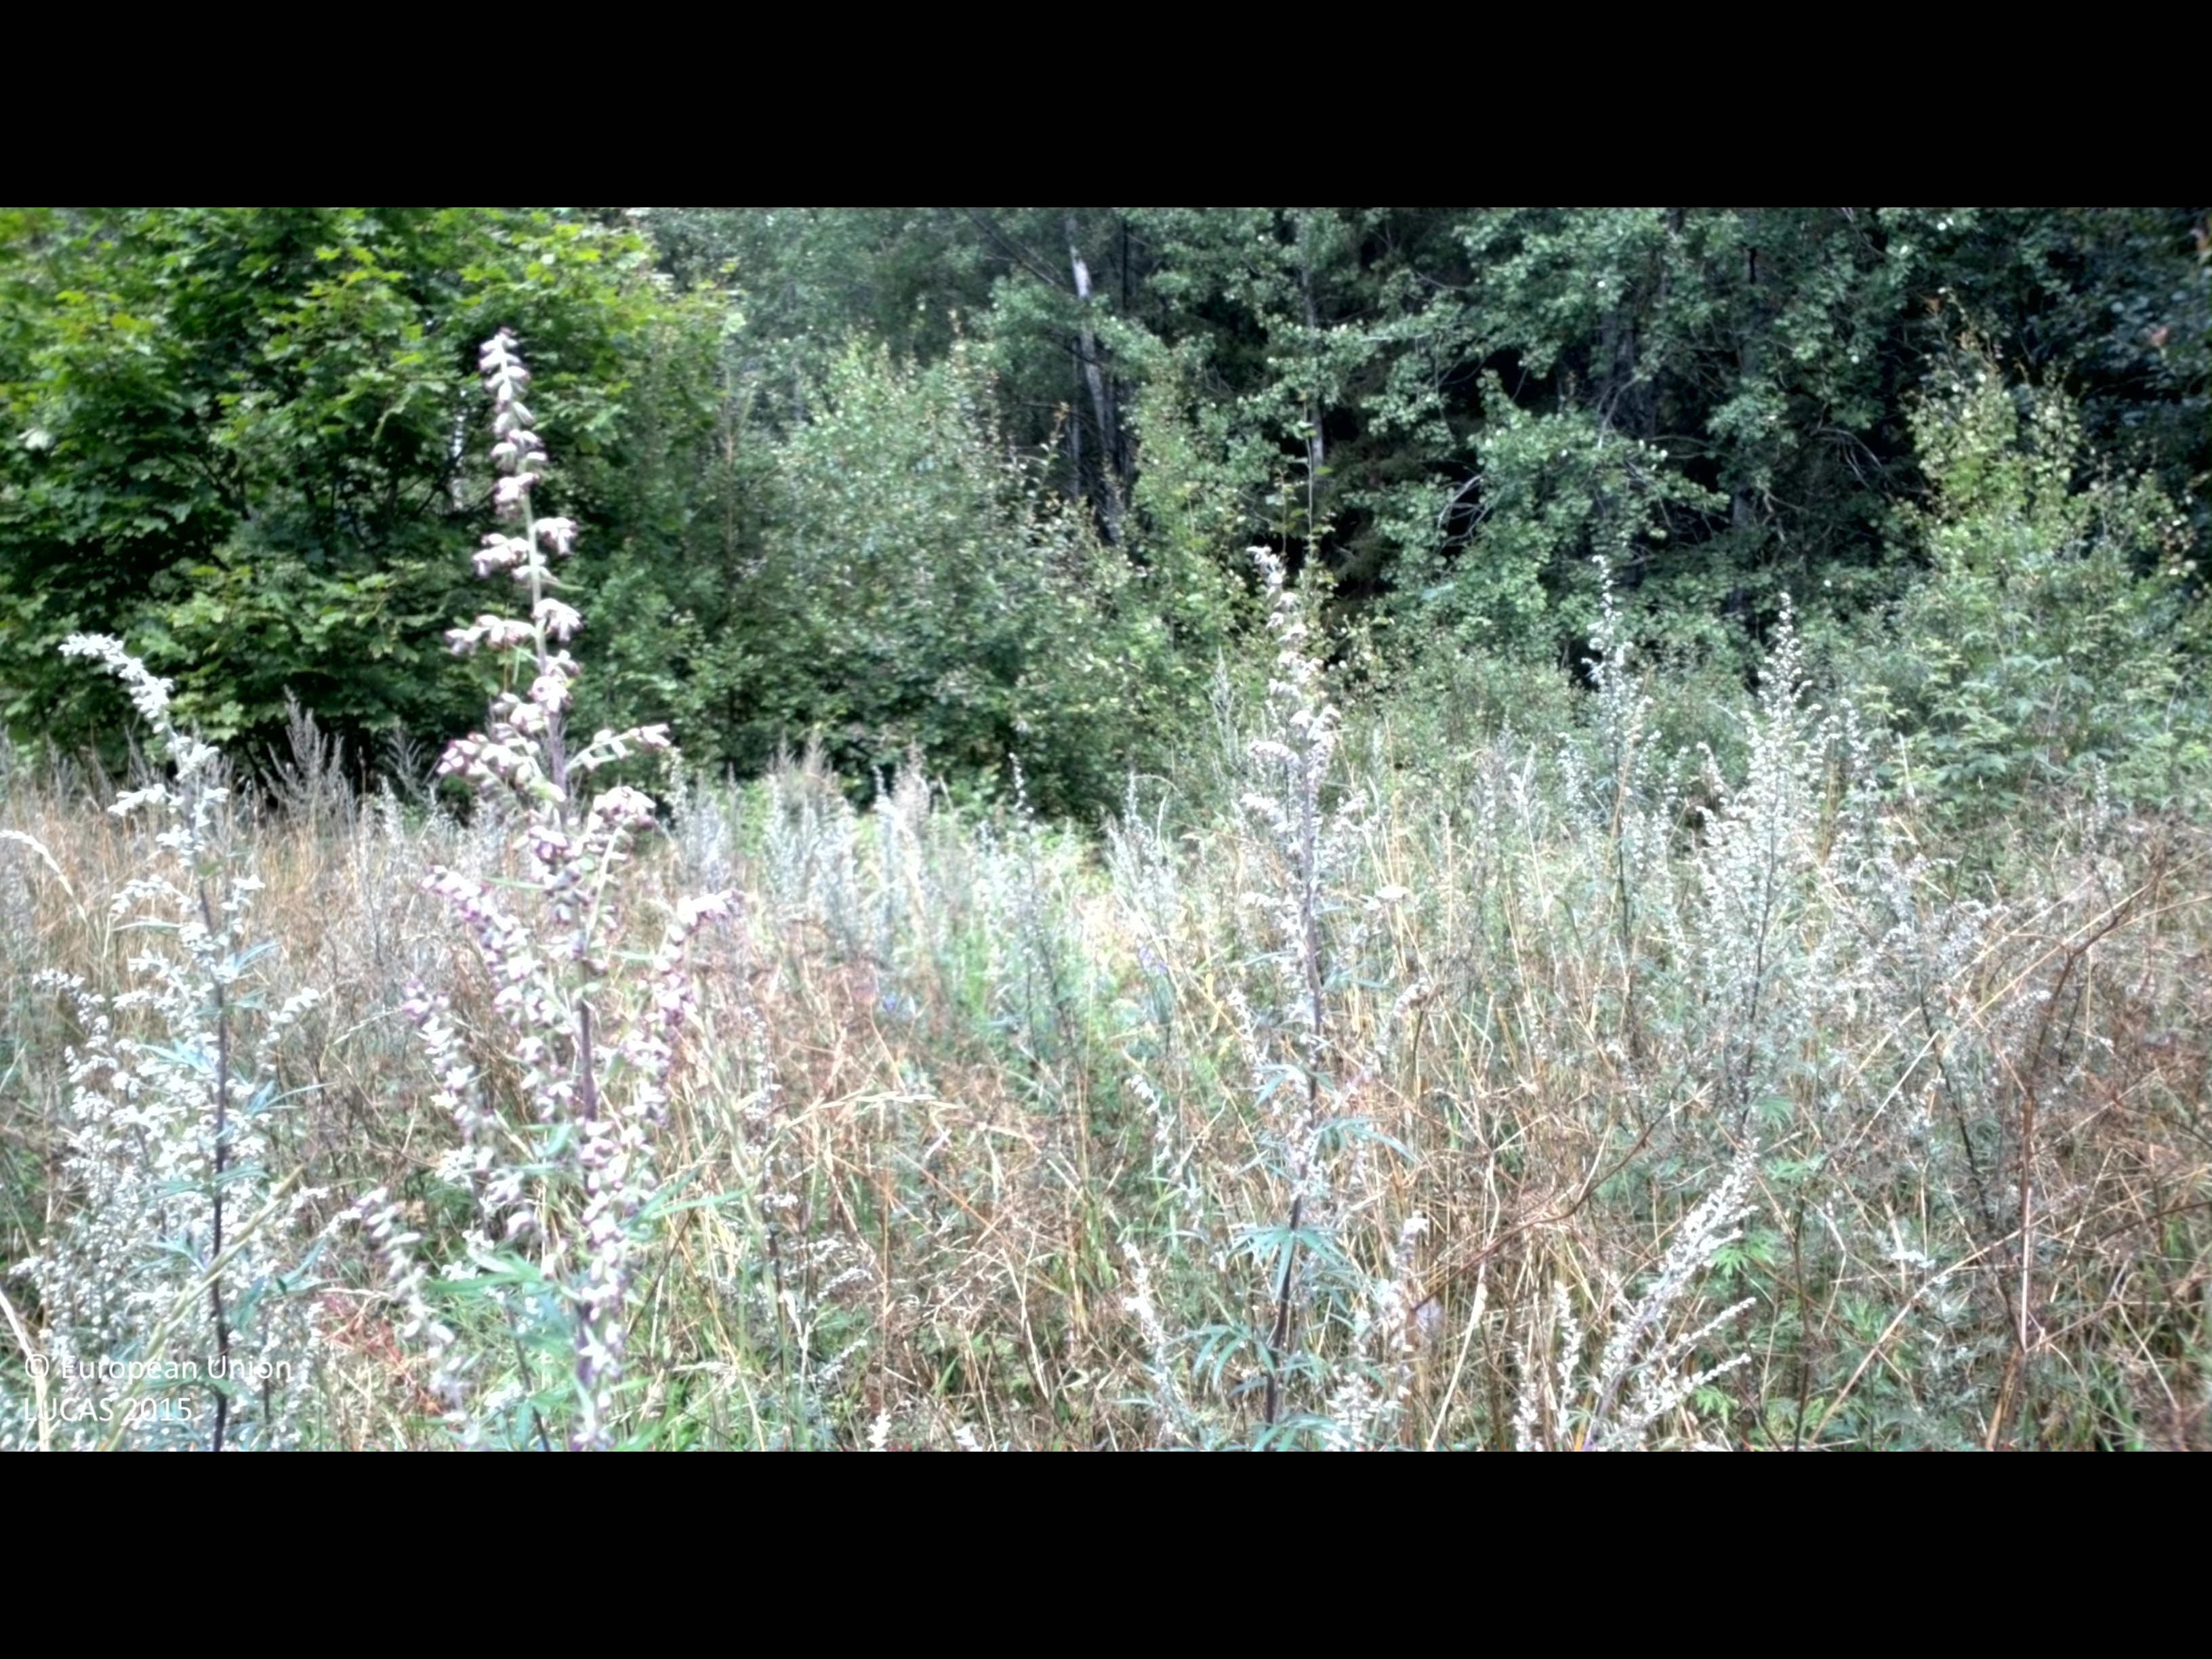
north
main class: Grassland
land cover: Grassland without tree/shrub cover
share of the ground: > 75 %
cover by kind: herbaceous plants 100 %
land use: Abandoned areas
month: August
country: SE
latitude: 56.3594
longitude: 15.0321
